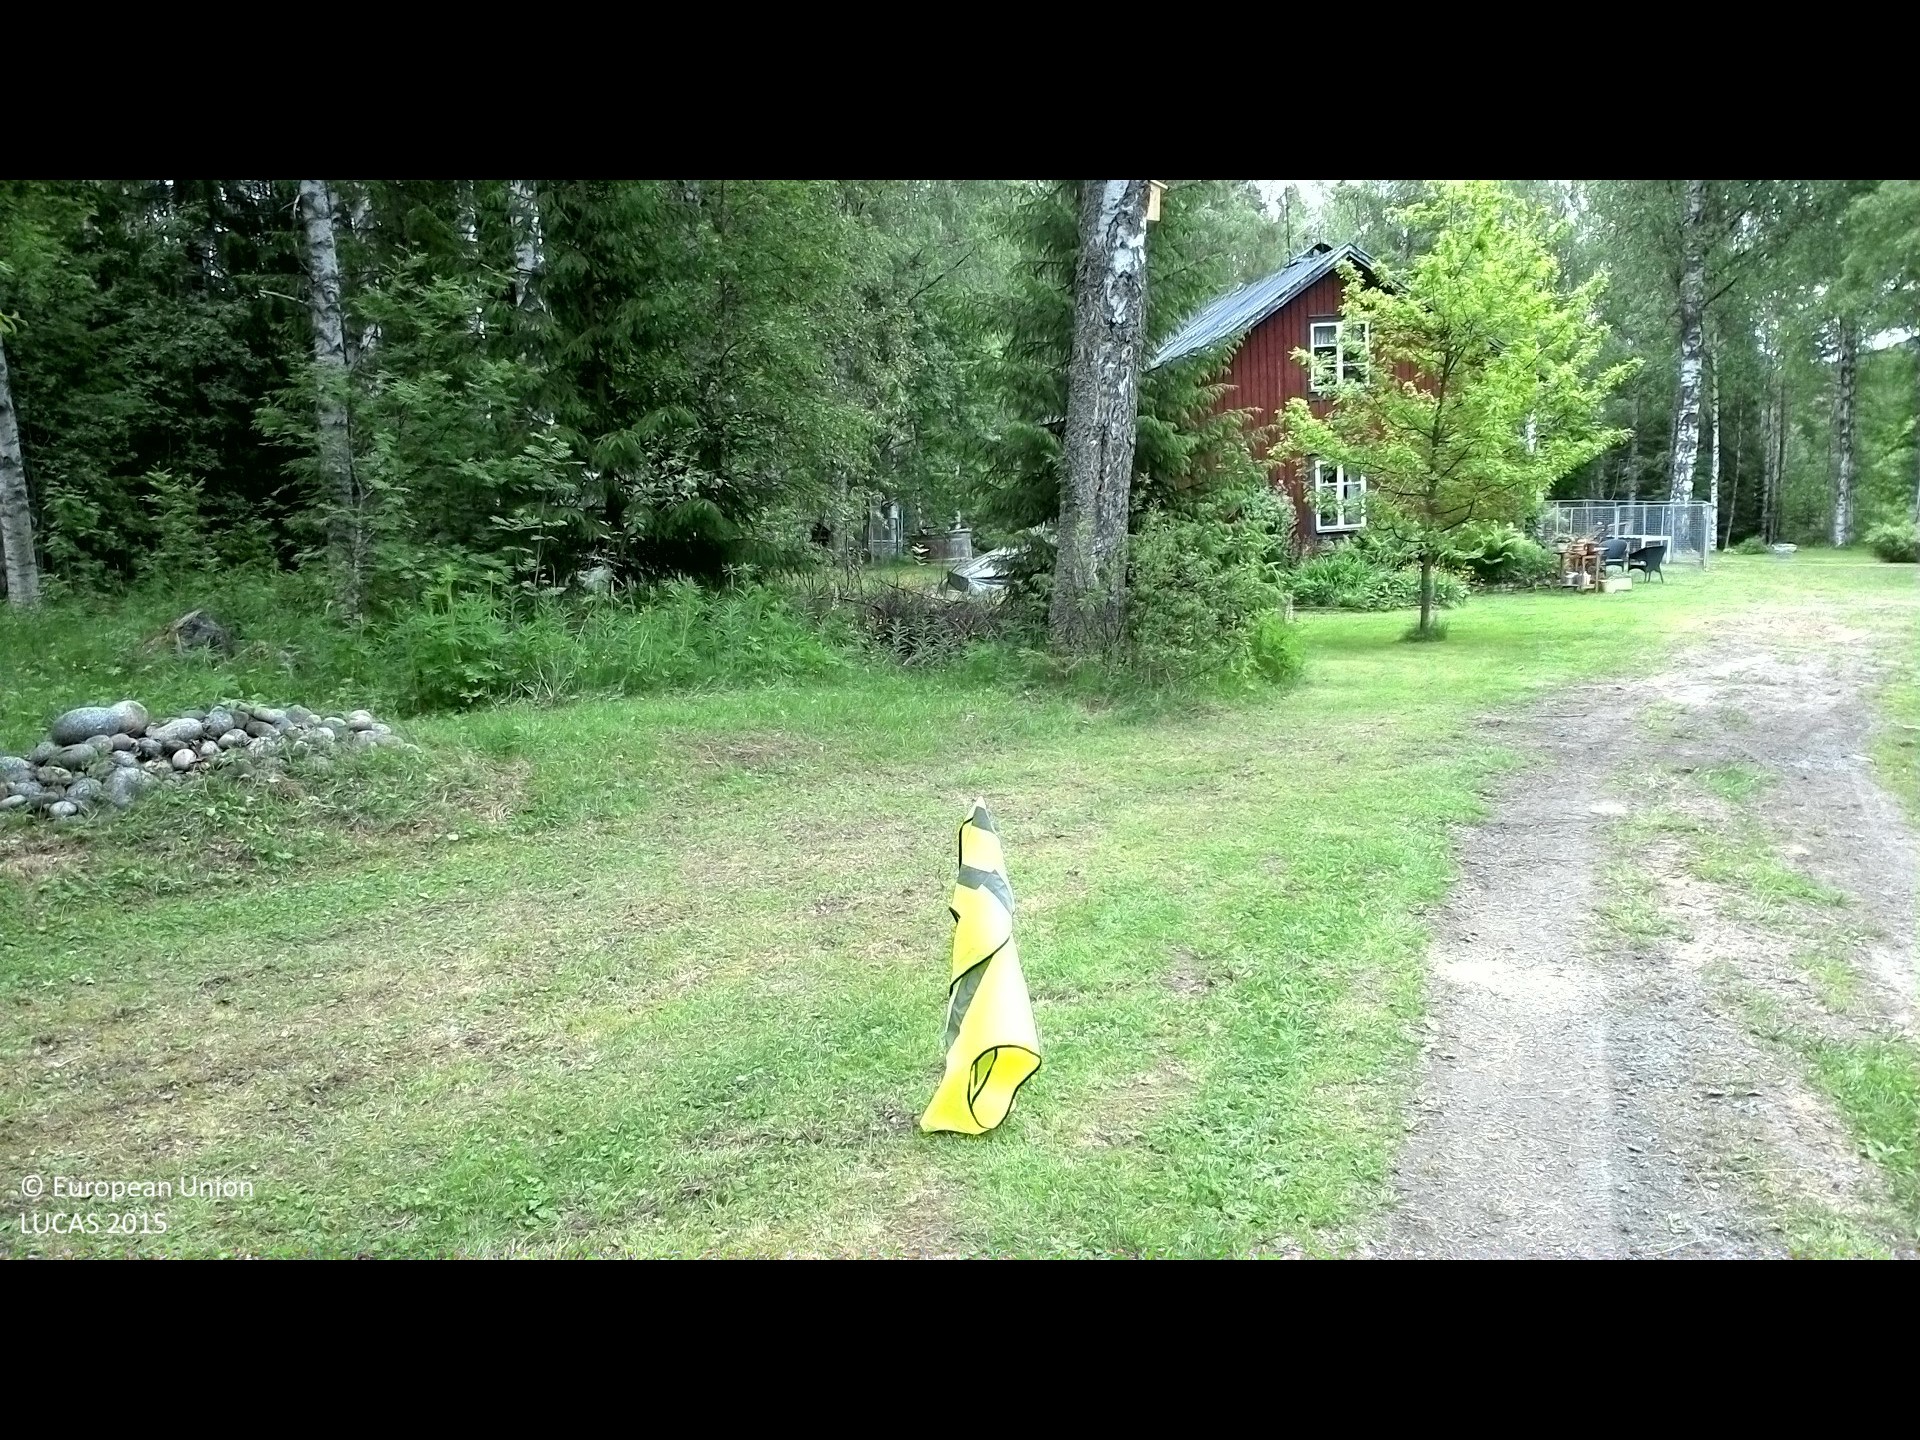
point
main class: Grassland
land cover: Grassland without tree/shrub cover
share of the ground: > 75 %
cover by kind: herbaceous plants 100 %
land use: Residential
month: June
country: SE
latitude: 62.0426
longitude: 16.3868
